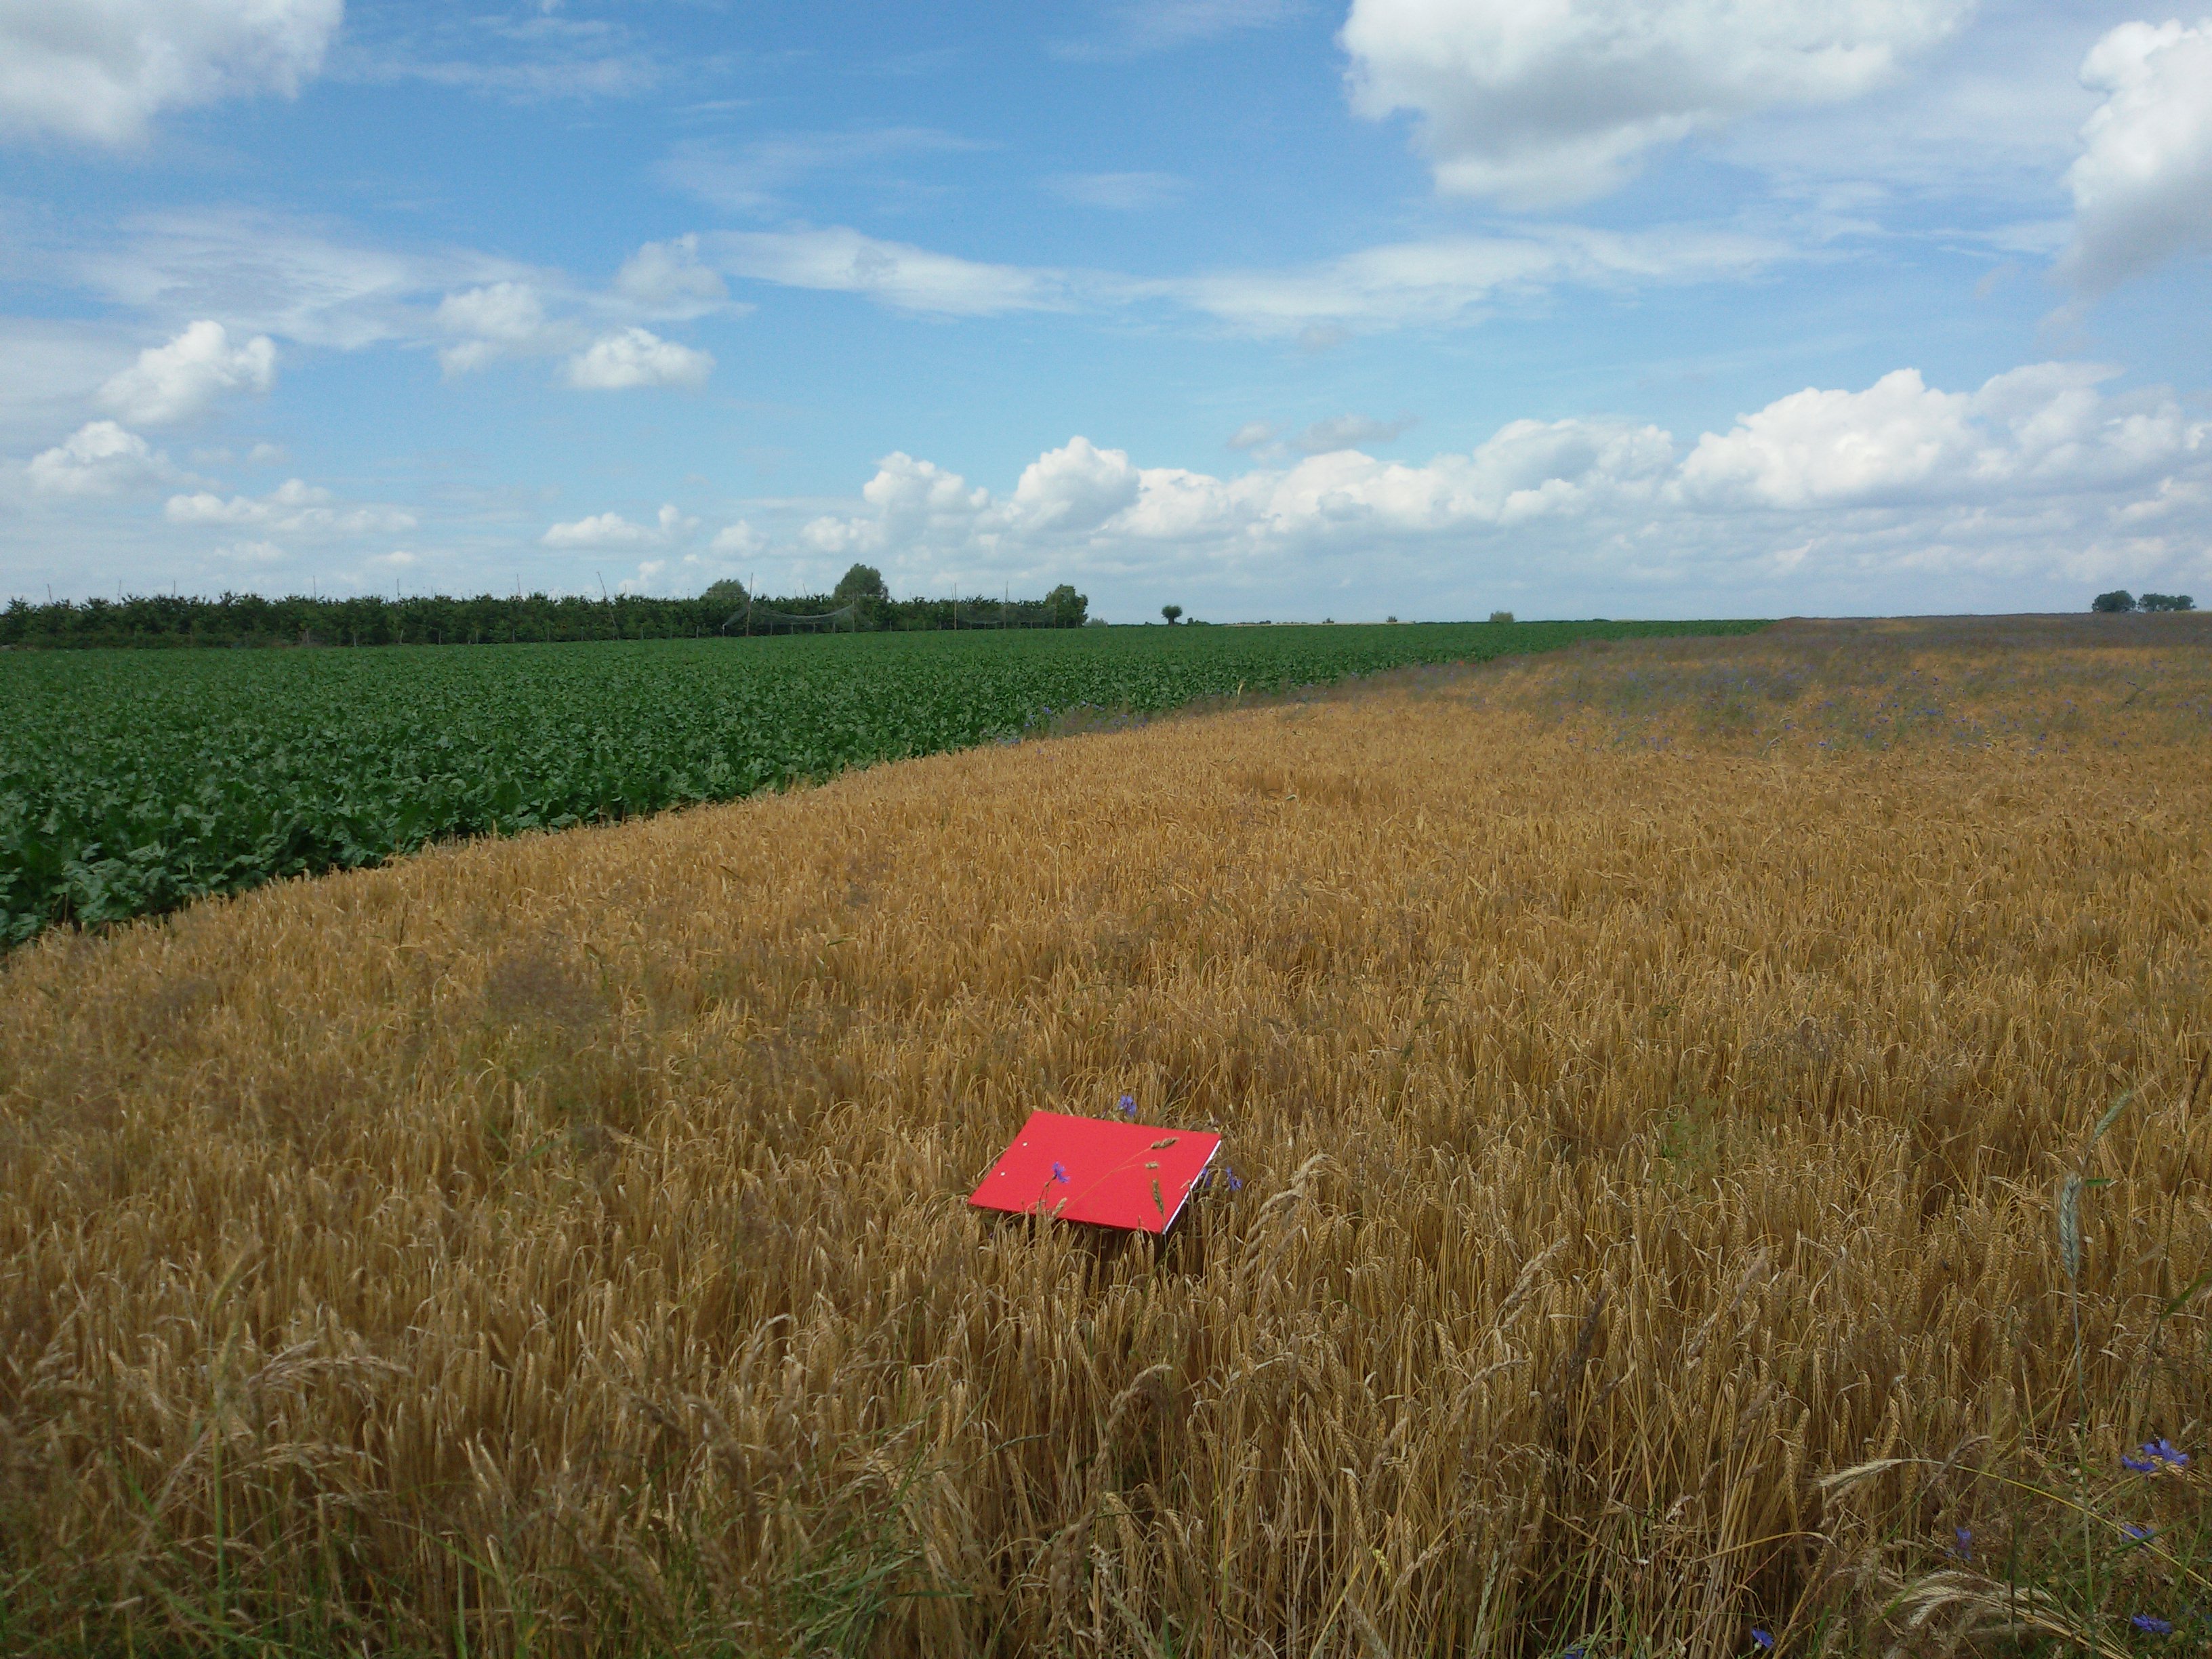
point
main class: Cropland
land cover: Barley
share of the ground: > 75 %
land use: Agriculture (excluding fallow land and kitchen gardens)
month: June
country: PL
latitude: 52.0176
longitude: 16.8433
